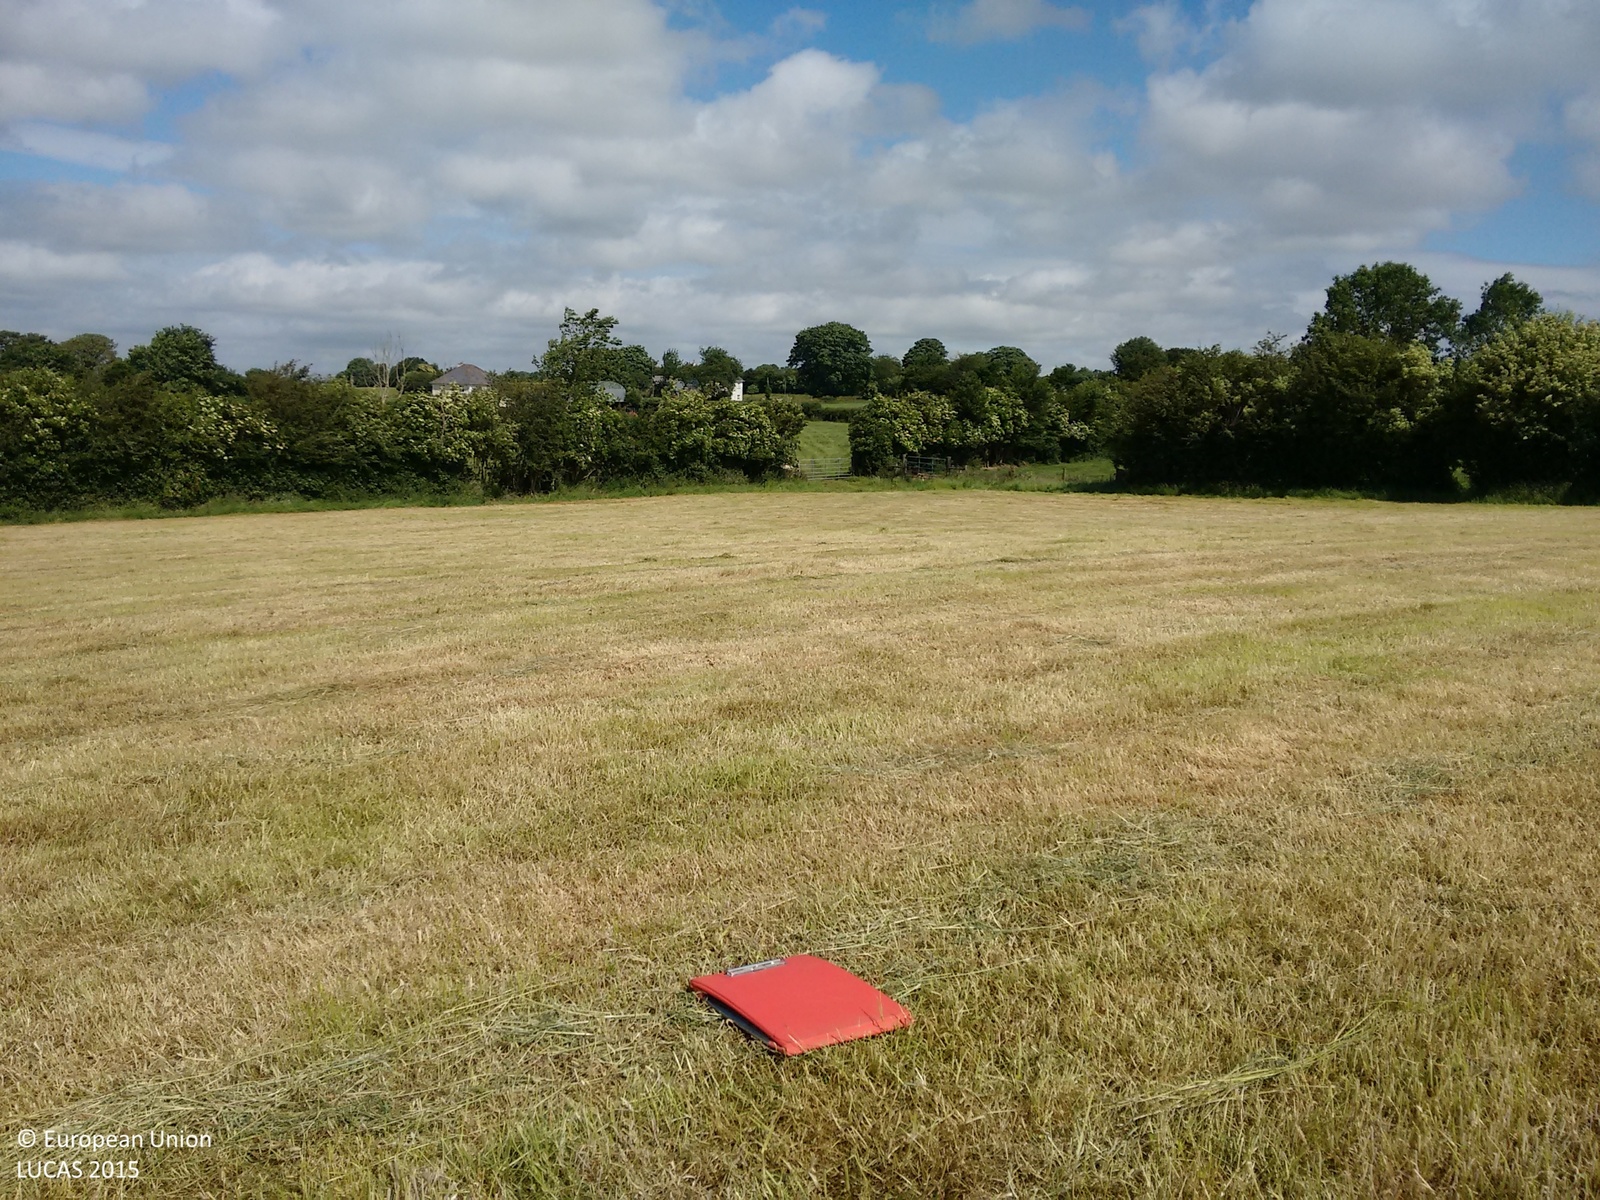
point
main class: Grassland
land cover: Grassland without tree/shrub cover
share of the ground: > 75 %
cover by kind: herbaceous plants 100 %
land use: Agriculture (excluding fallow land and kitchen gardens)
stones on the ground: < 10 %
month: June
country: IE
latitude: 53.7079
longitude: -6.7843
